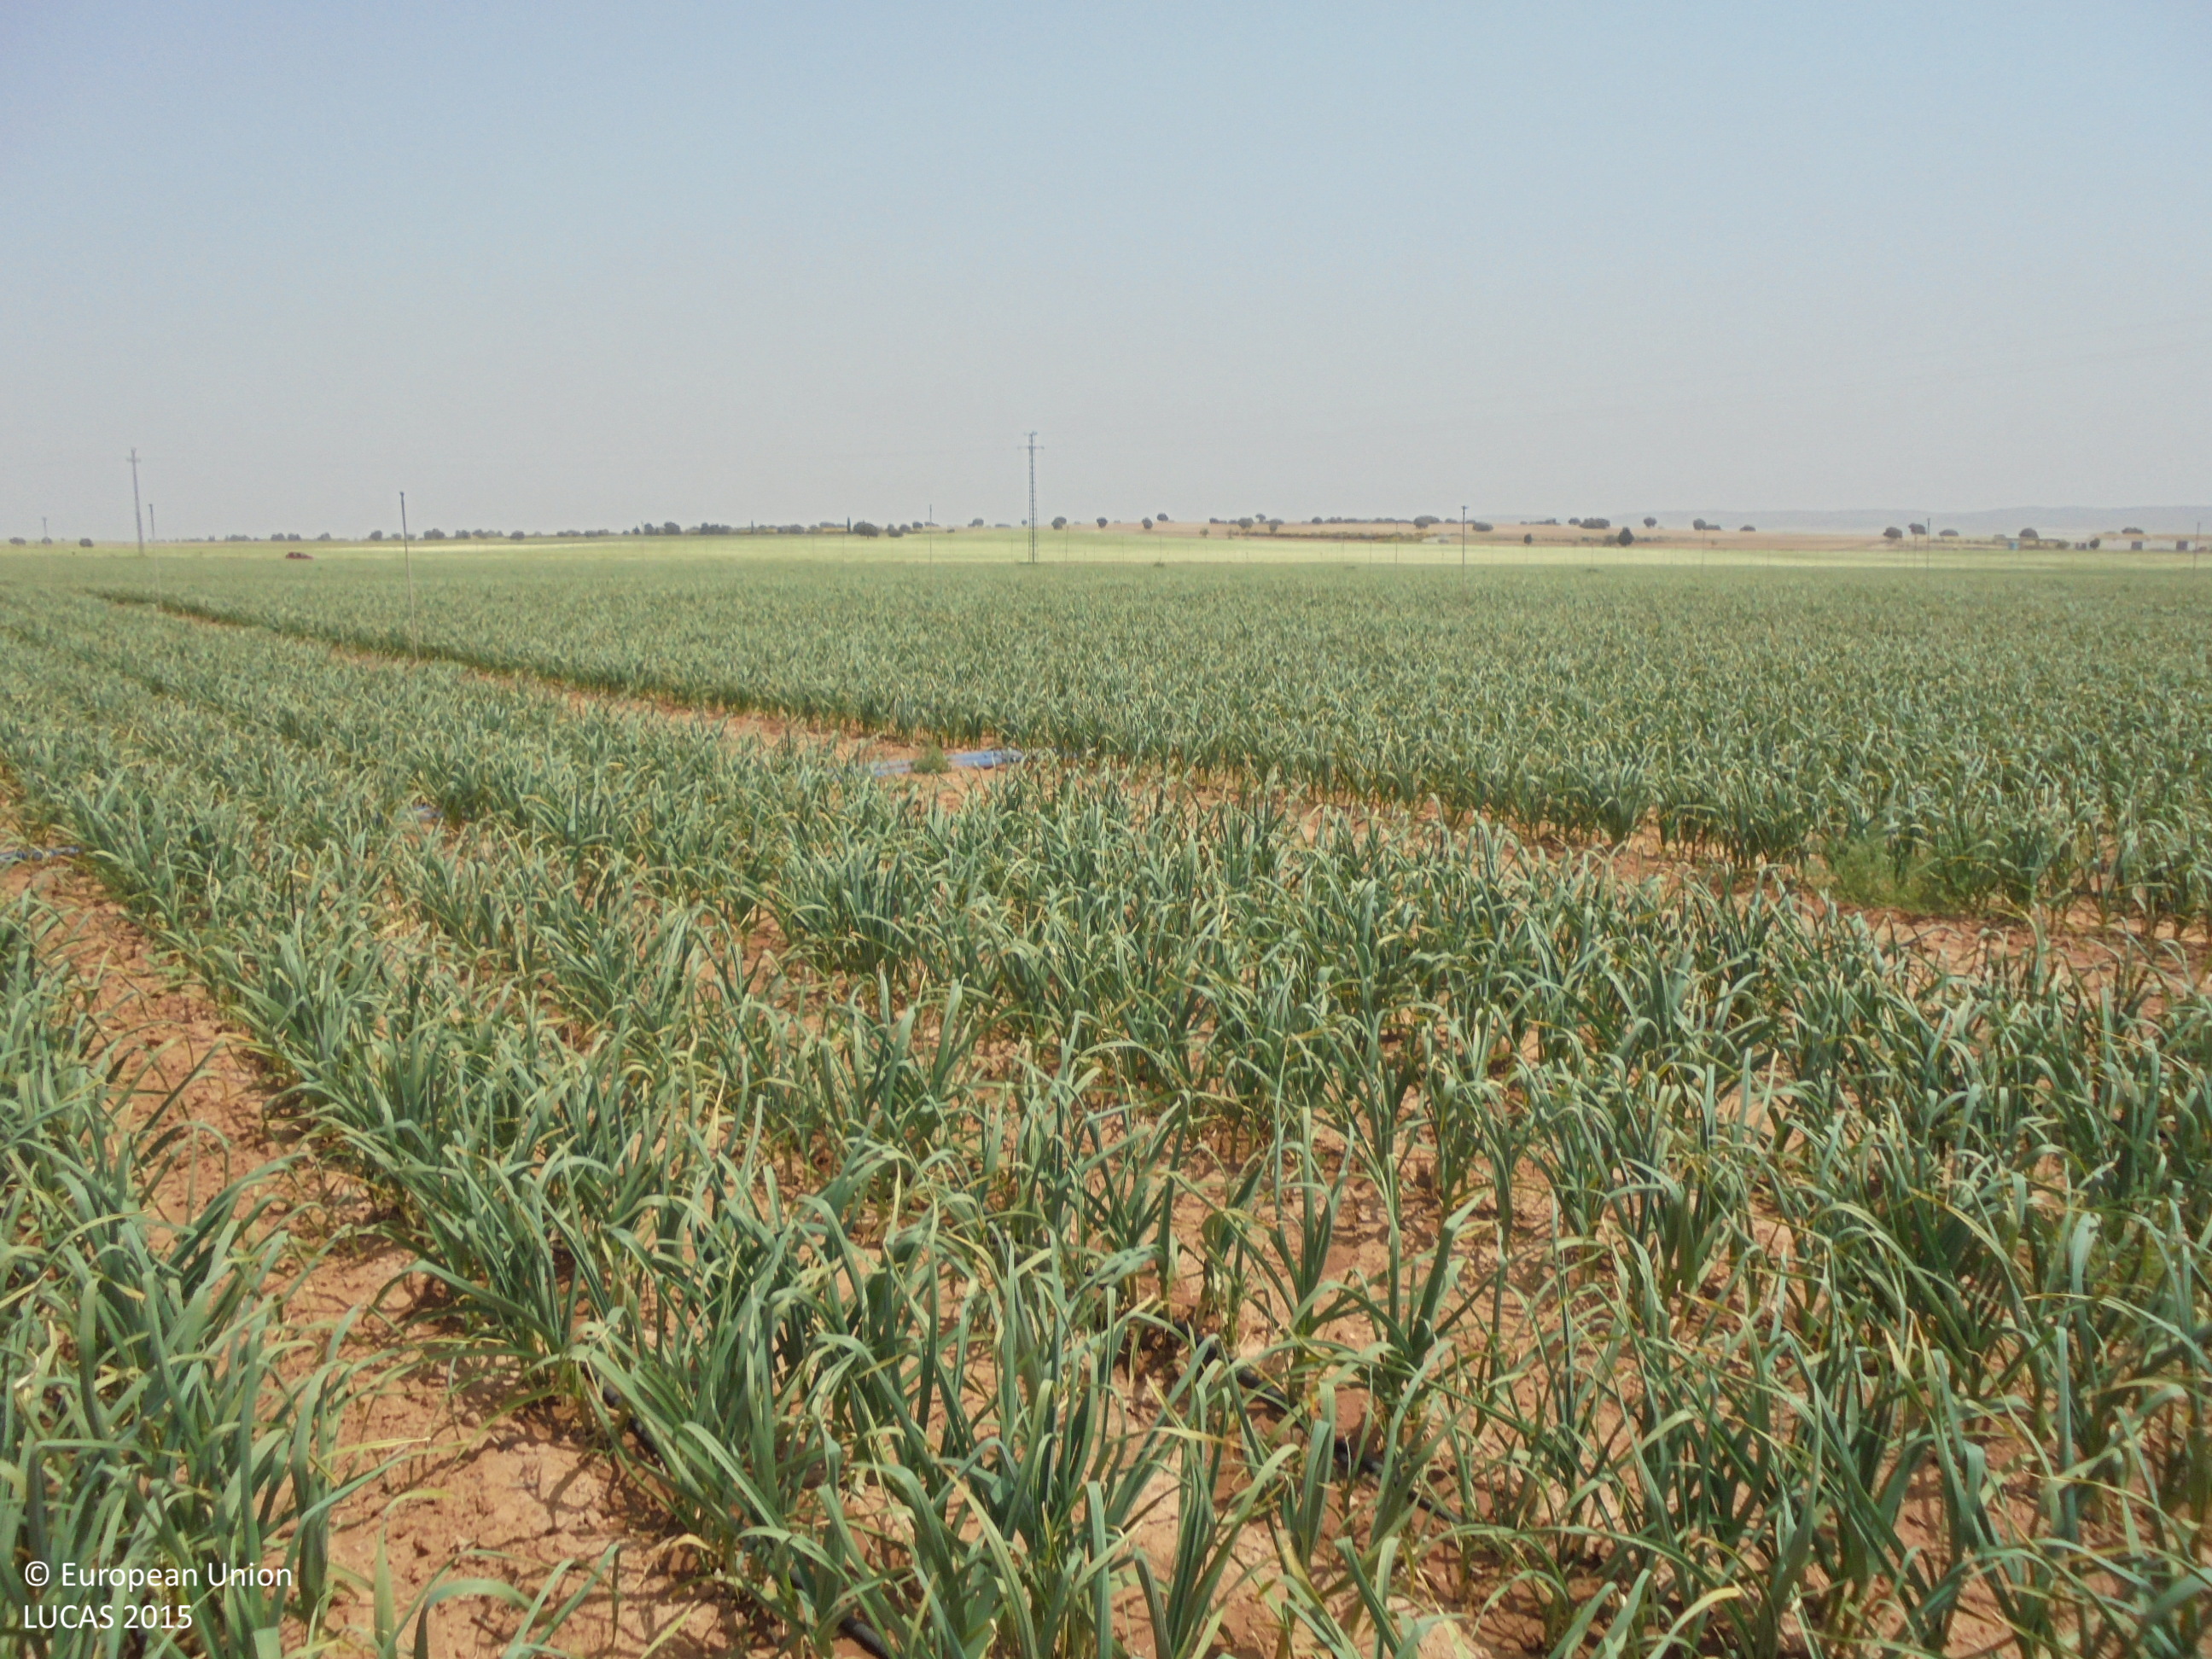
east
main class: Cropland
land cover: Other root crops
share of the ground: 25 - 50 %
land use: Agriculture (excluding fallow land and kitchen gardens)
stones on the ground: < 10 %
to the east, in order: Other root crops; Electric lines; Other root crops
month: May
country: ES
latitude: 39.0855
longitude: -1.7347
